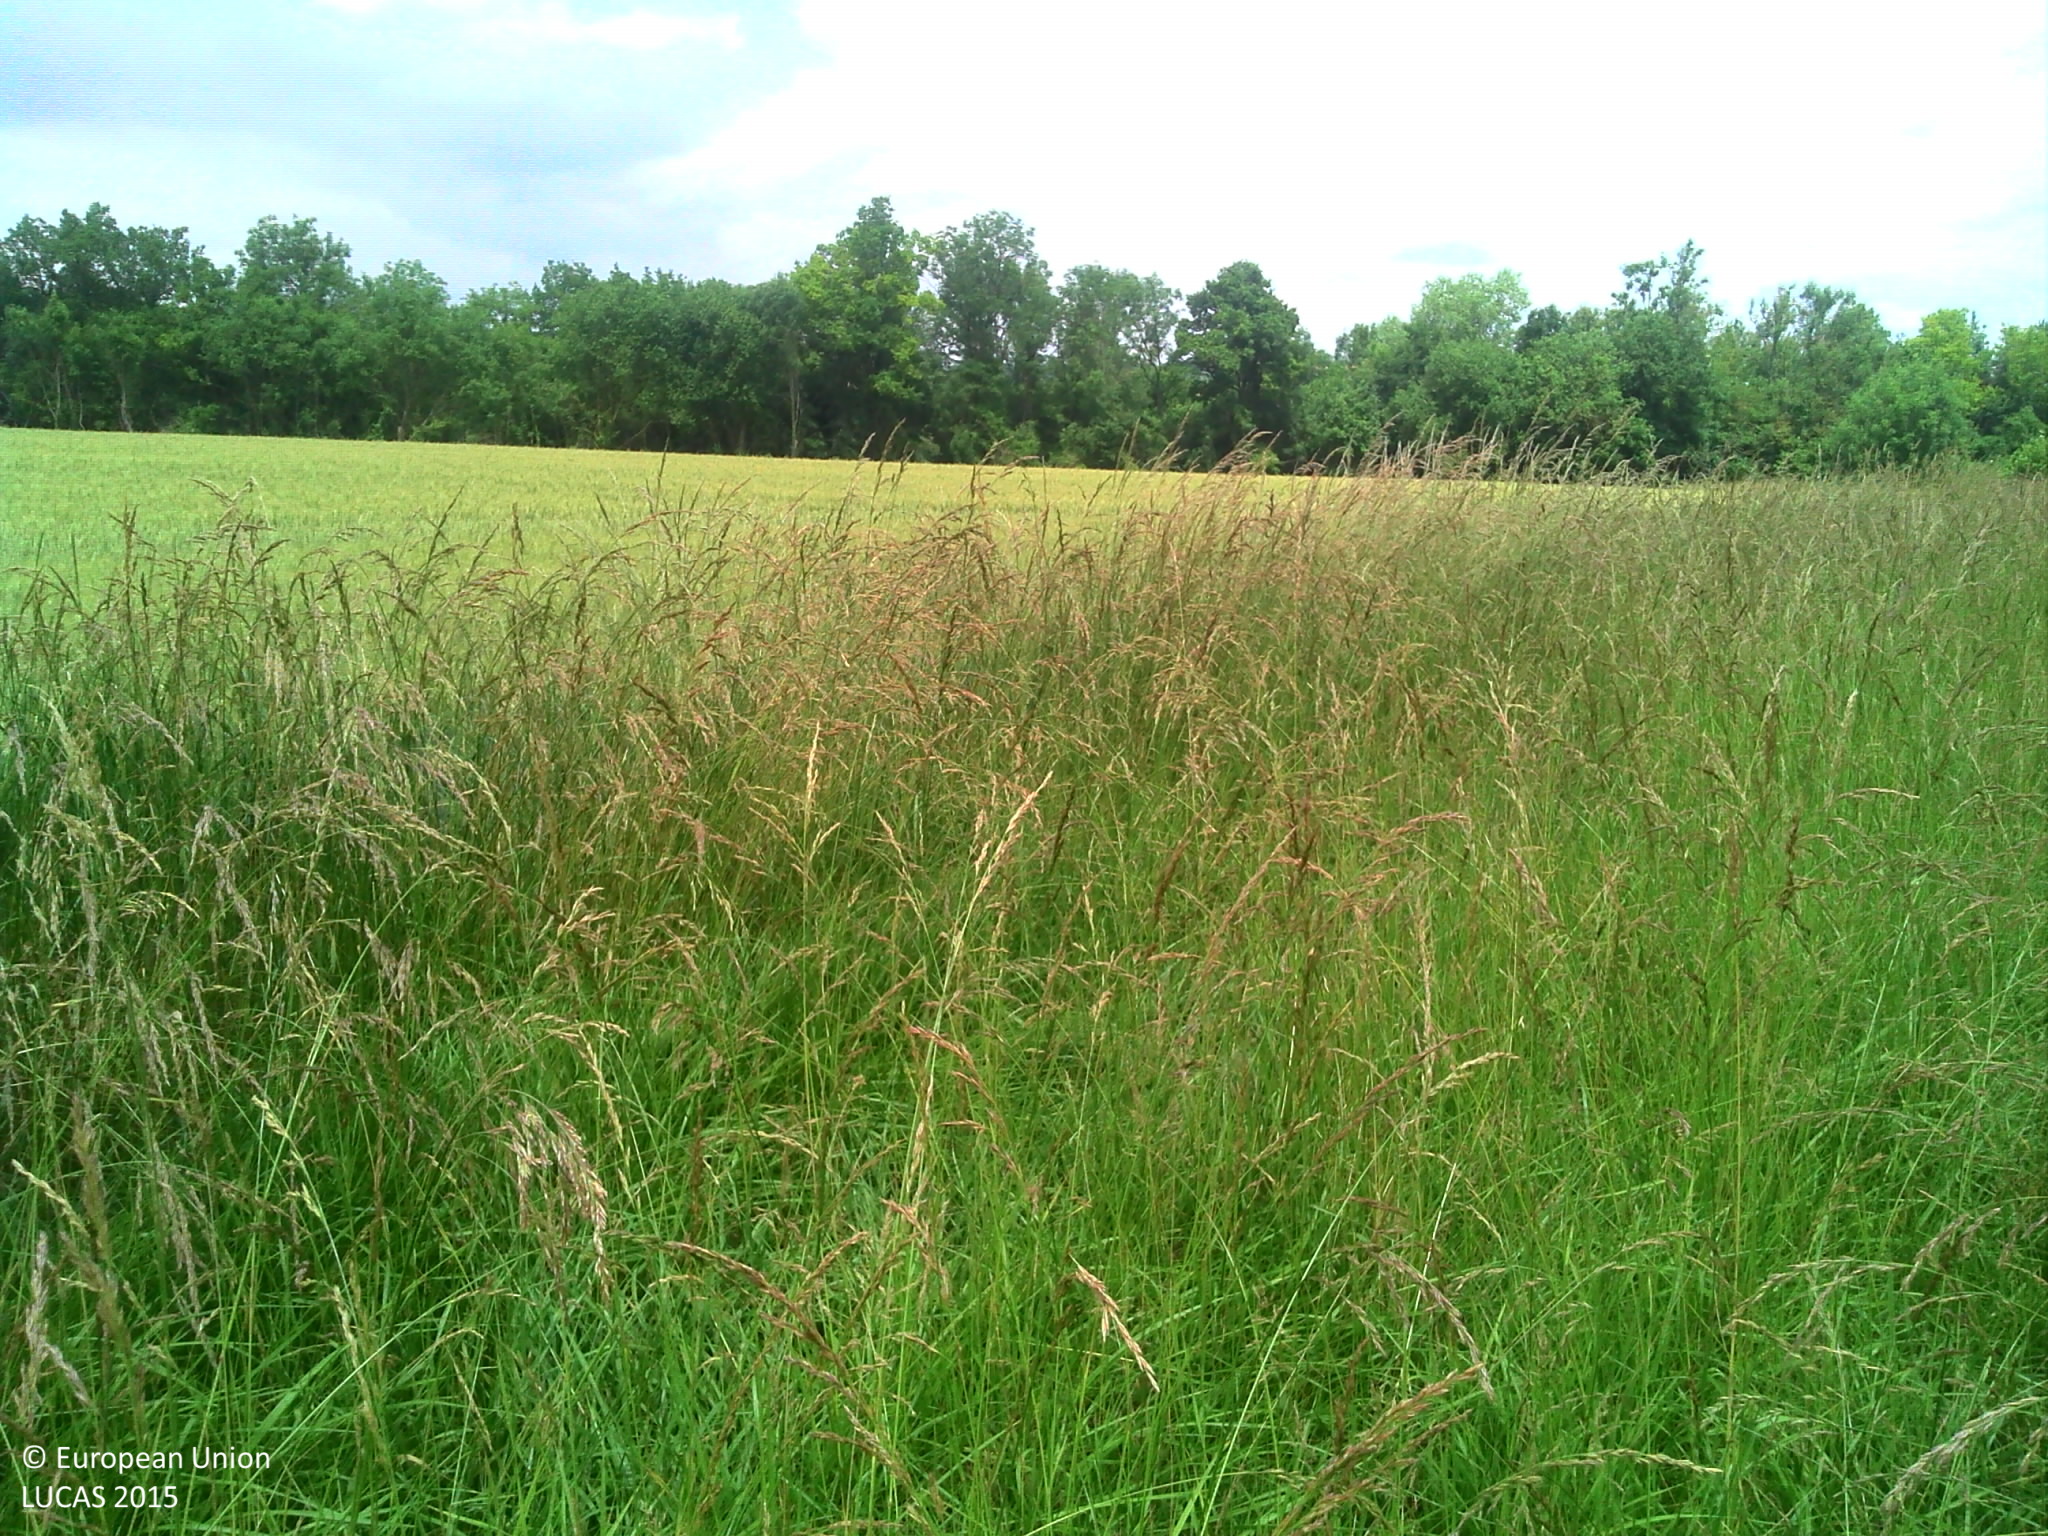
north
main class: Grassland
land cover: Grassland without tree/shrub cover
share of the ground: > 75 %
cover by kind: herbaceous plants 100 %
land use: Agriculture (excluding fallow land and kitchen gardens)
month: June
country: FR
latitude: 49.3786
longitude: 3.6991
